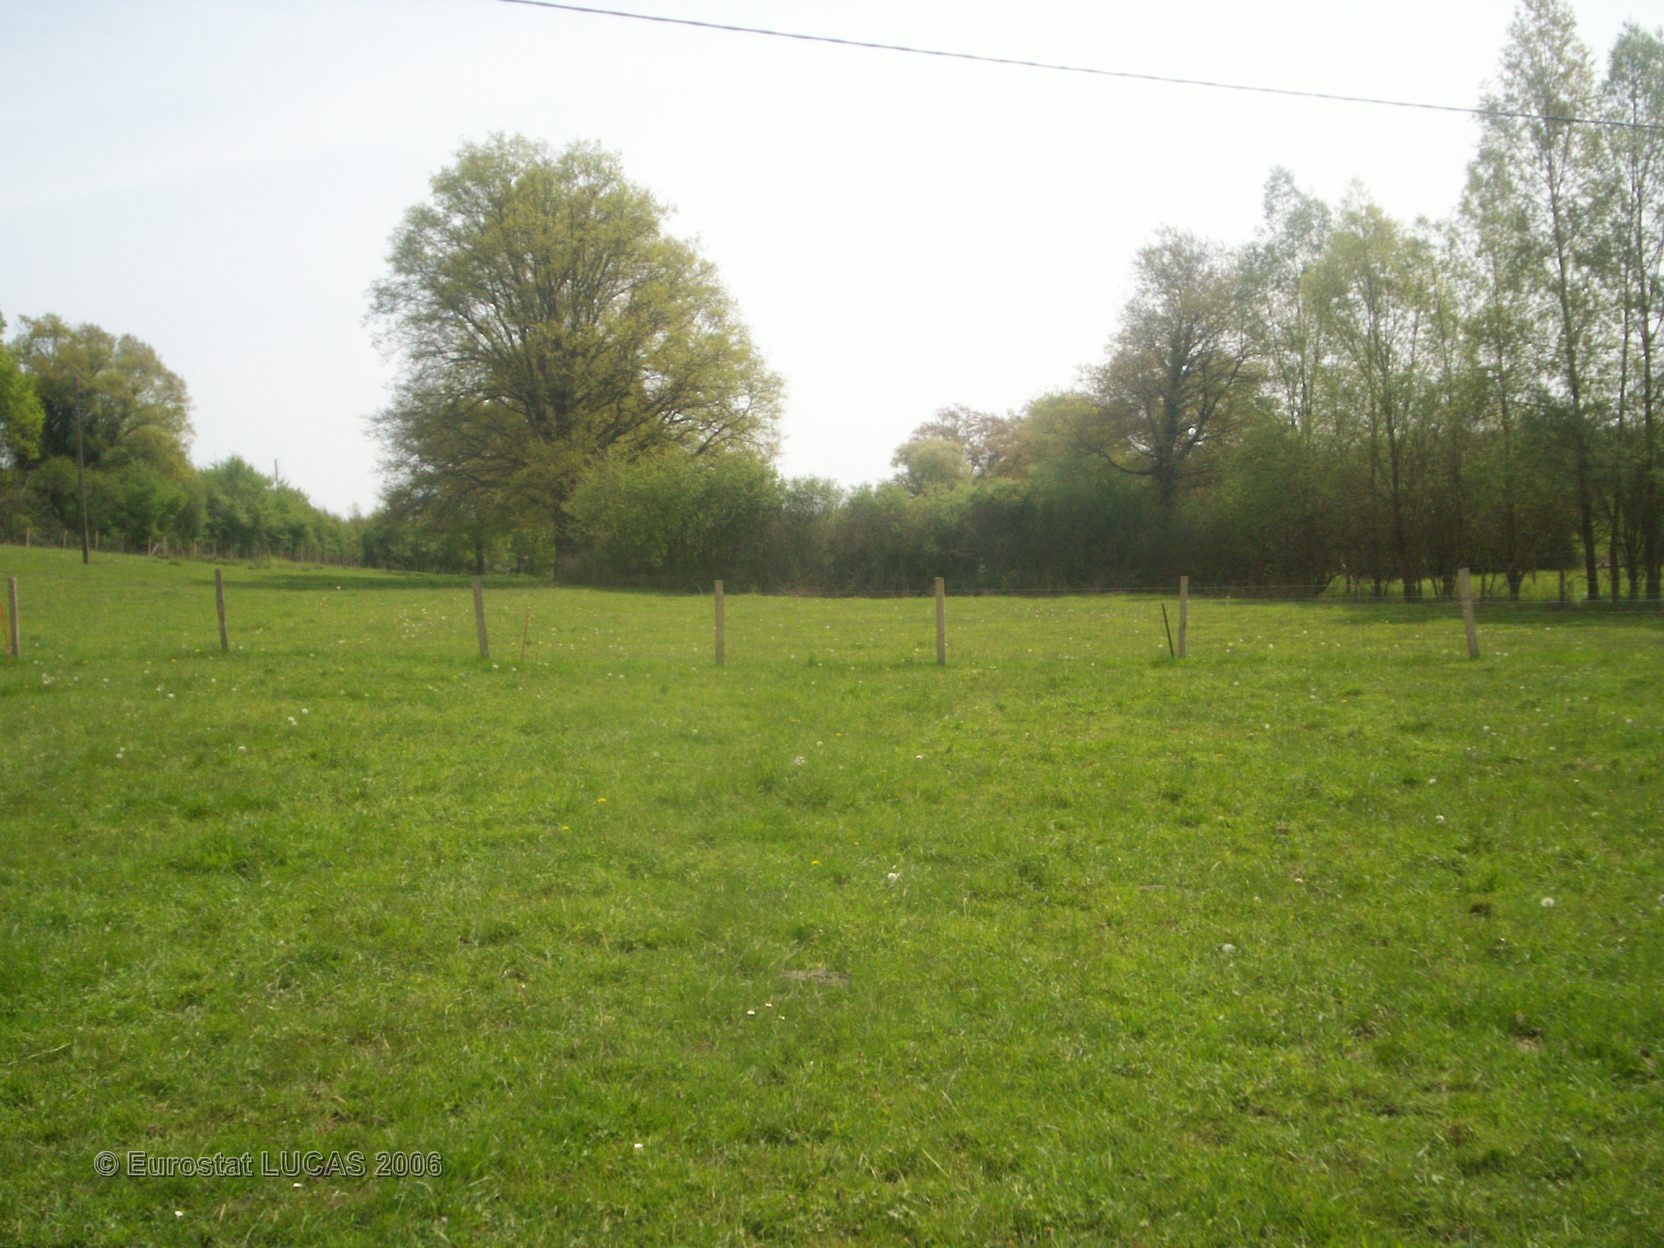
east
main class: Grassland
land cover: Grassland without tree/shrub cover
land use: Agriculture (excluding fallow land and kitchen gardens)
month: May
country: FR
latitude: 46.5439
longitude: 3.0988
